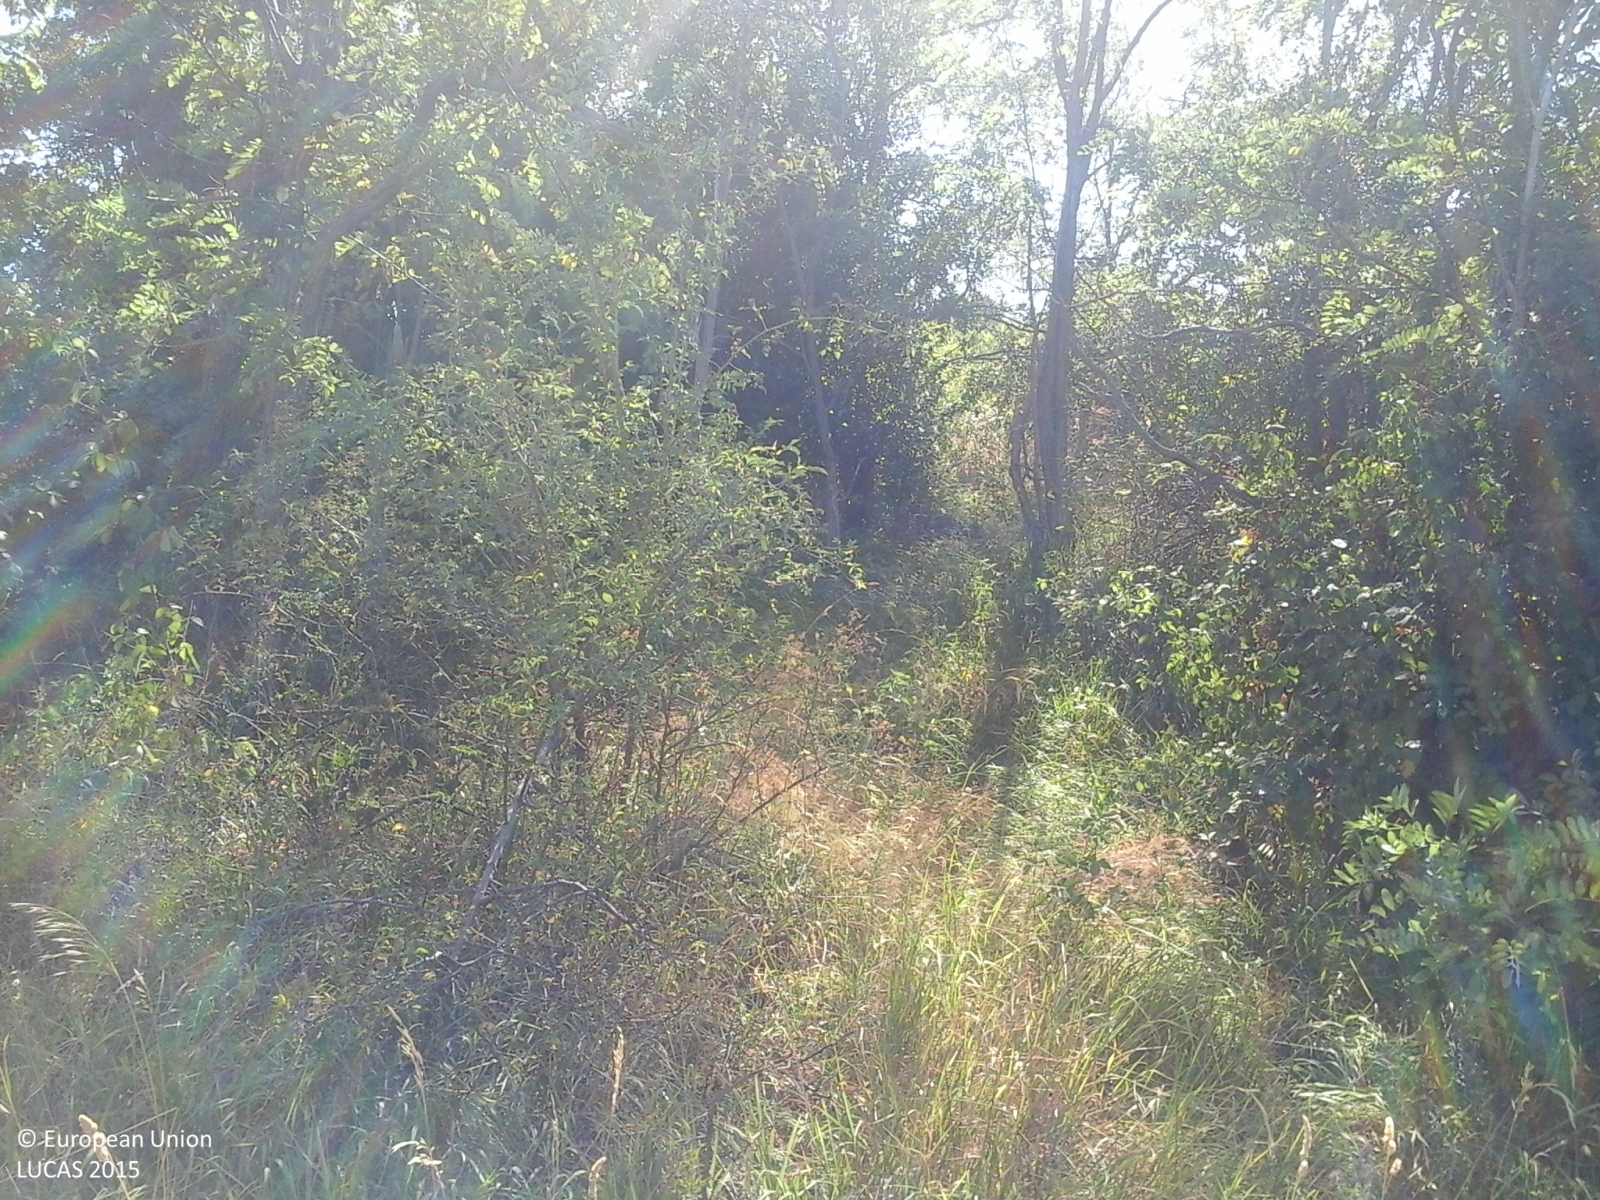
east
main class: Woodland
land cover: Broadleaved woodland
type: thermophilous deciduous forest
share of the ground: > 75 %
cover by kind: broadleaved forest trees 75 %, shrubs 25 %
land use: Forestry
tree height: > 5 m
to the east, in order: Broadleaved woodland; Fences; Tracks; Fences; Grassland with sparse tree/shrub cover; Broadleaved woodland; Tracks; Broadleaved woodland; Shrubland with sparse tree cover; Broadleaved woodland; Paved roads, cycling and walking lanes; Grass margins; Broadleaved woodland
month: July
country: IT
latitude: 43.9478
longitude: 12.2250
